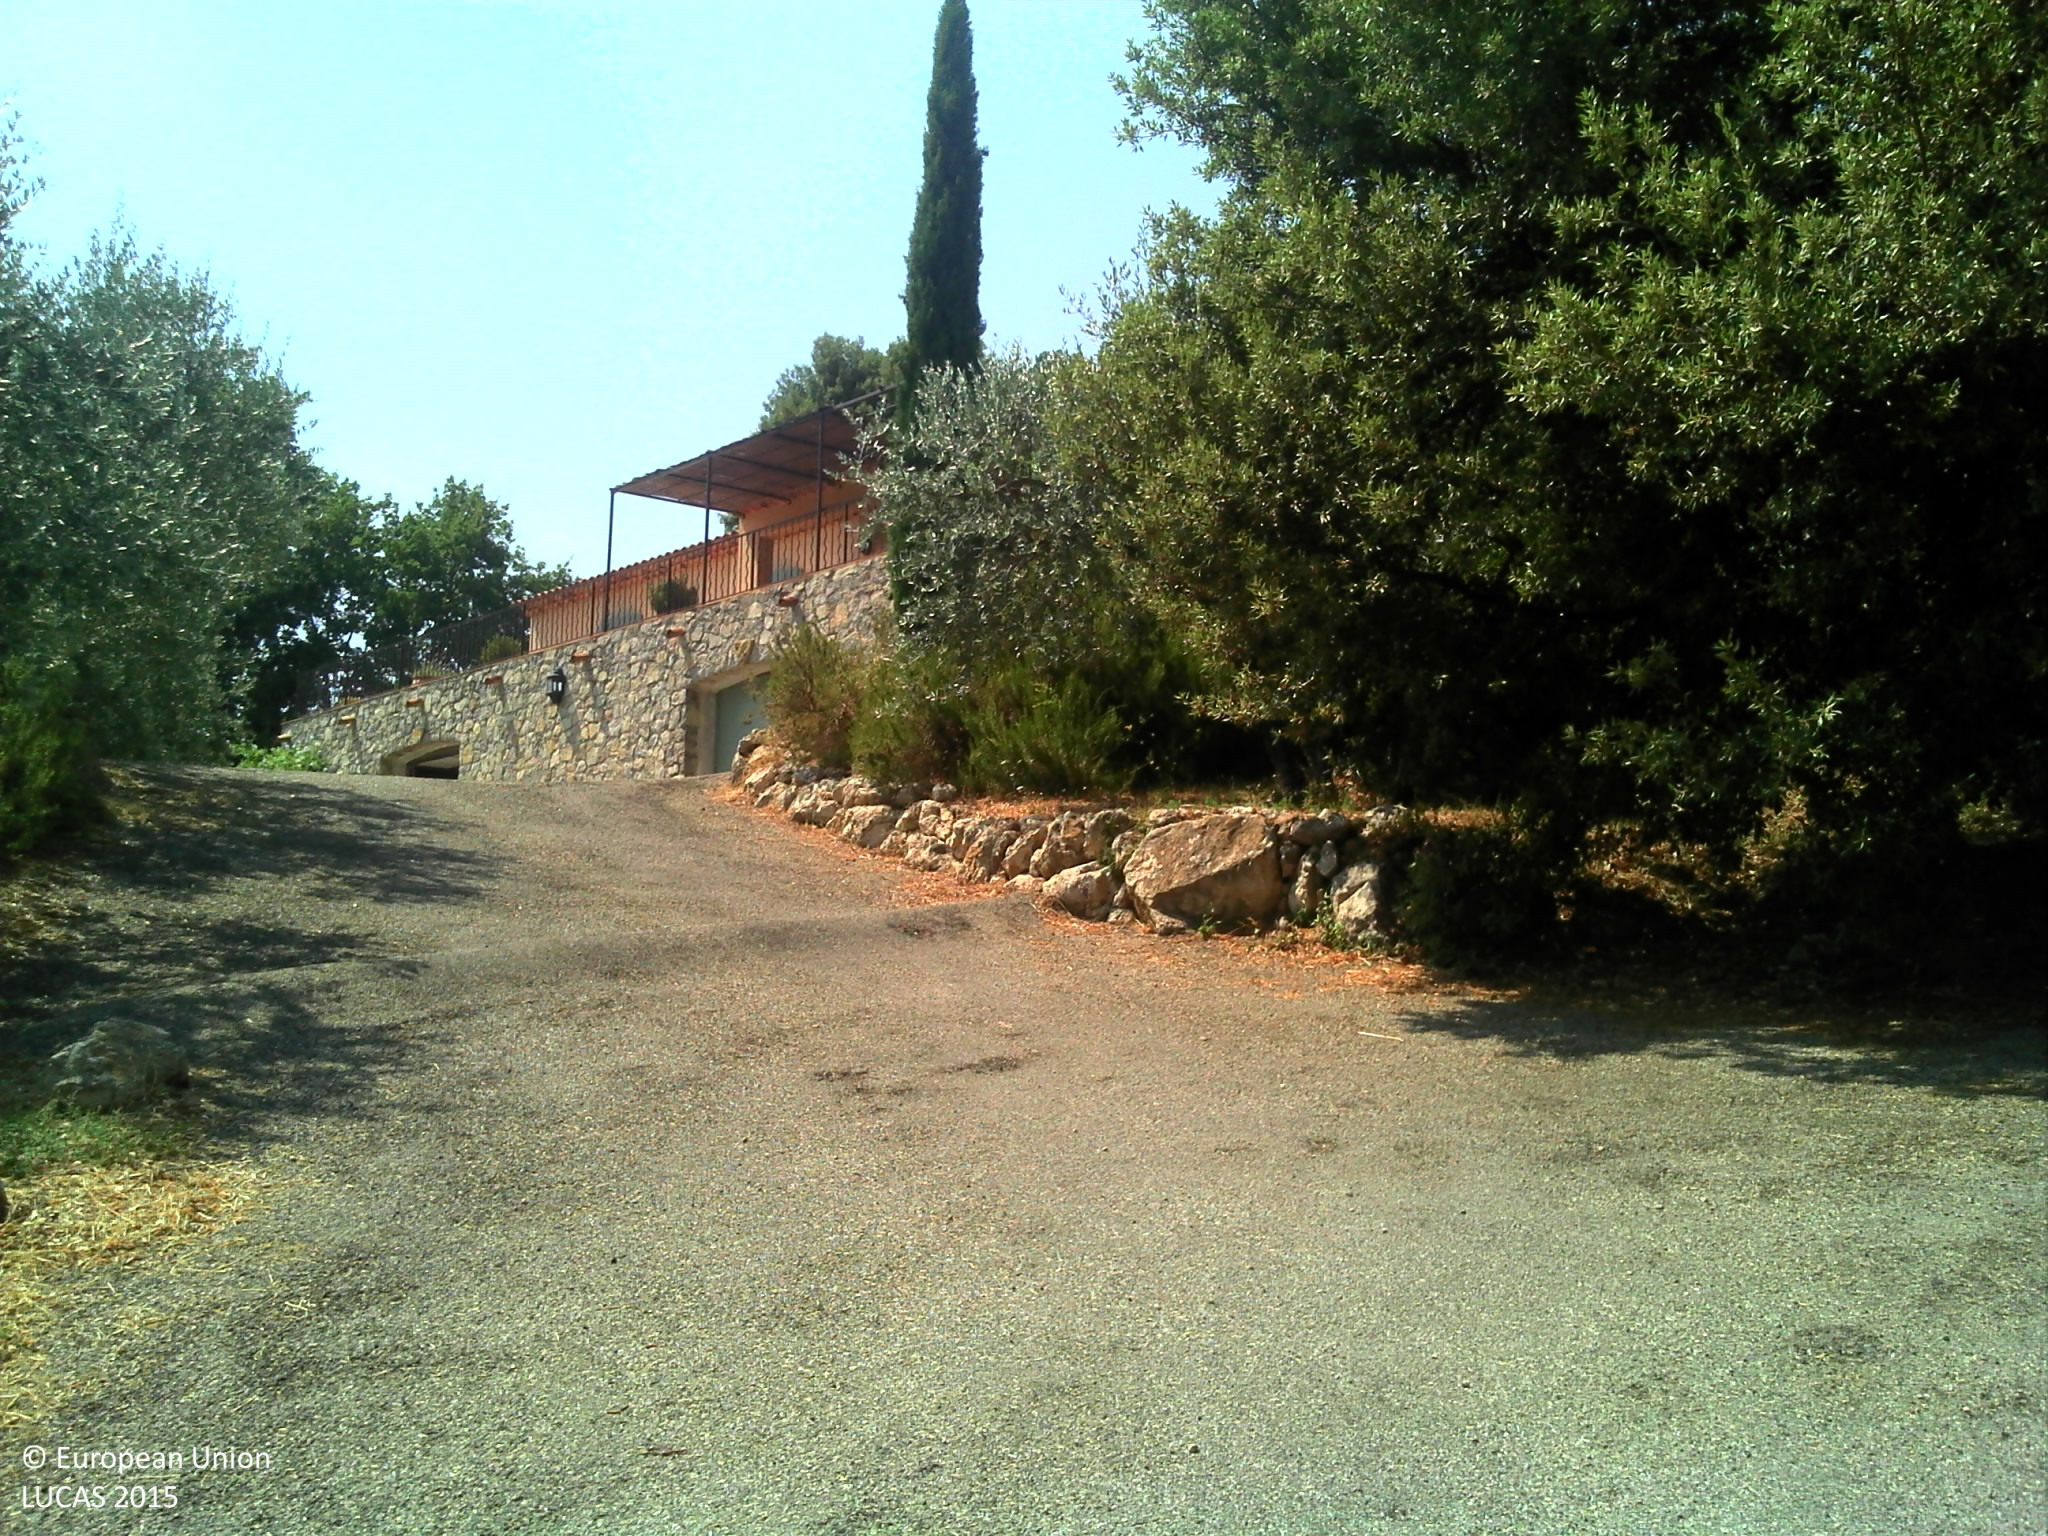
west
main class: Grassland
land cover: Grassland with sparse tree/shrub cover
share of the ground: > 75 %
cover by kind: herbaceous plants 85 %, shrubs 10 %, coniferous forest trees 5 %
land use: Residential
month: August
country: FR
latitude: 43.5694
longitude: 6.5043
